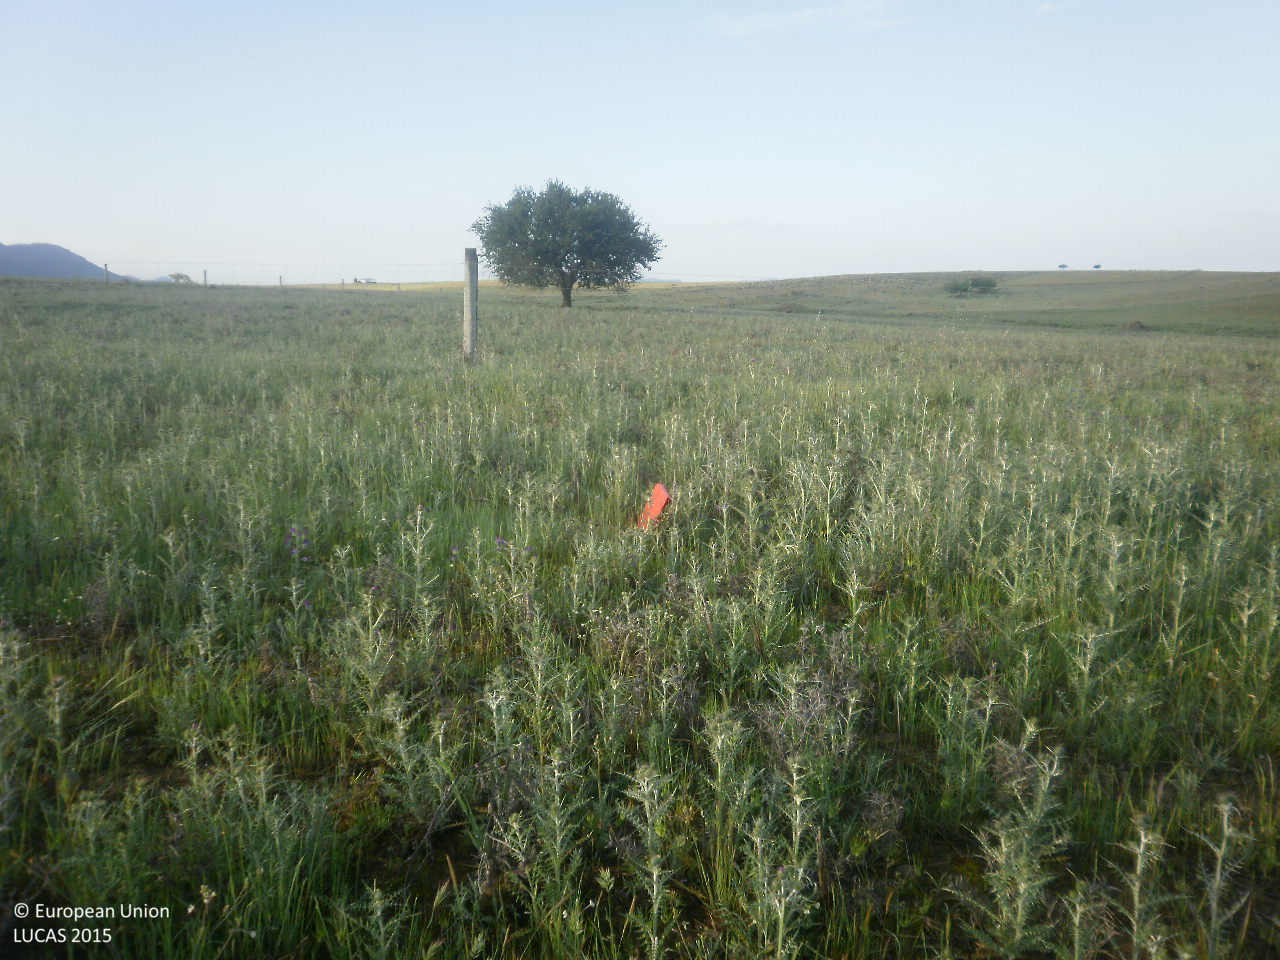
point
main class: Grassland
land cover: Grassland without tree/shrub cover
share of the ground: > 75 %
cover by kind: herbaceous plants 100 %
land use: Agriculture (excluding fallow land and kitchen gardens)
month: April
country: ES
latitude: 38.8209
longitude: -5.1814
